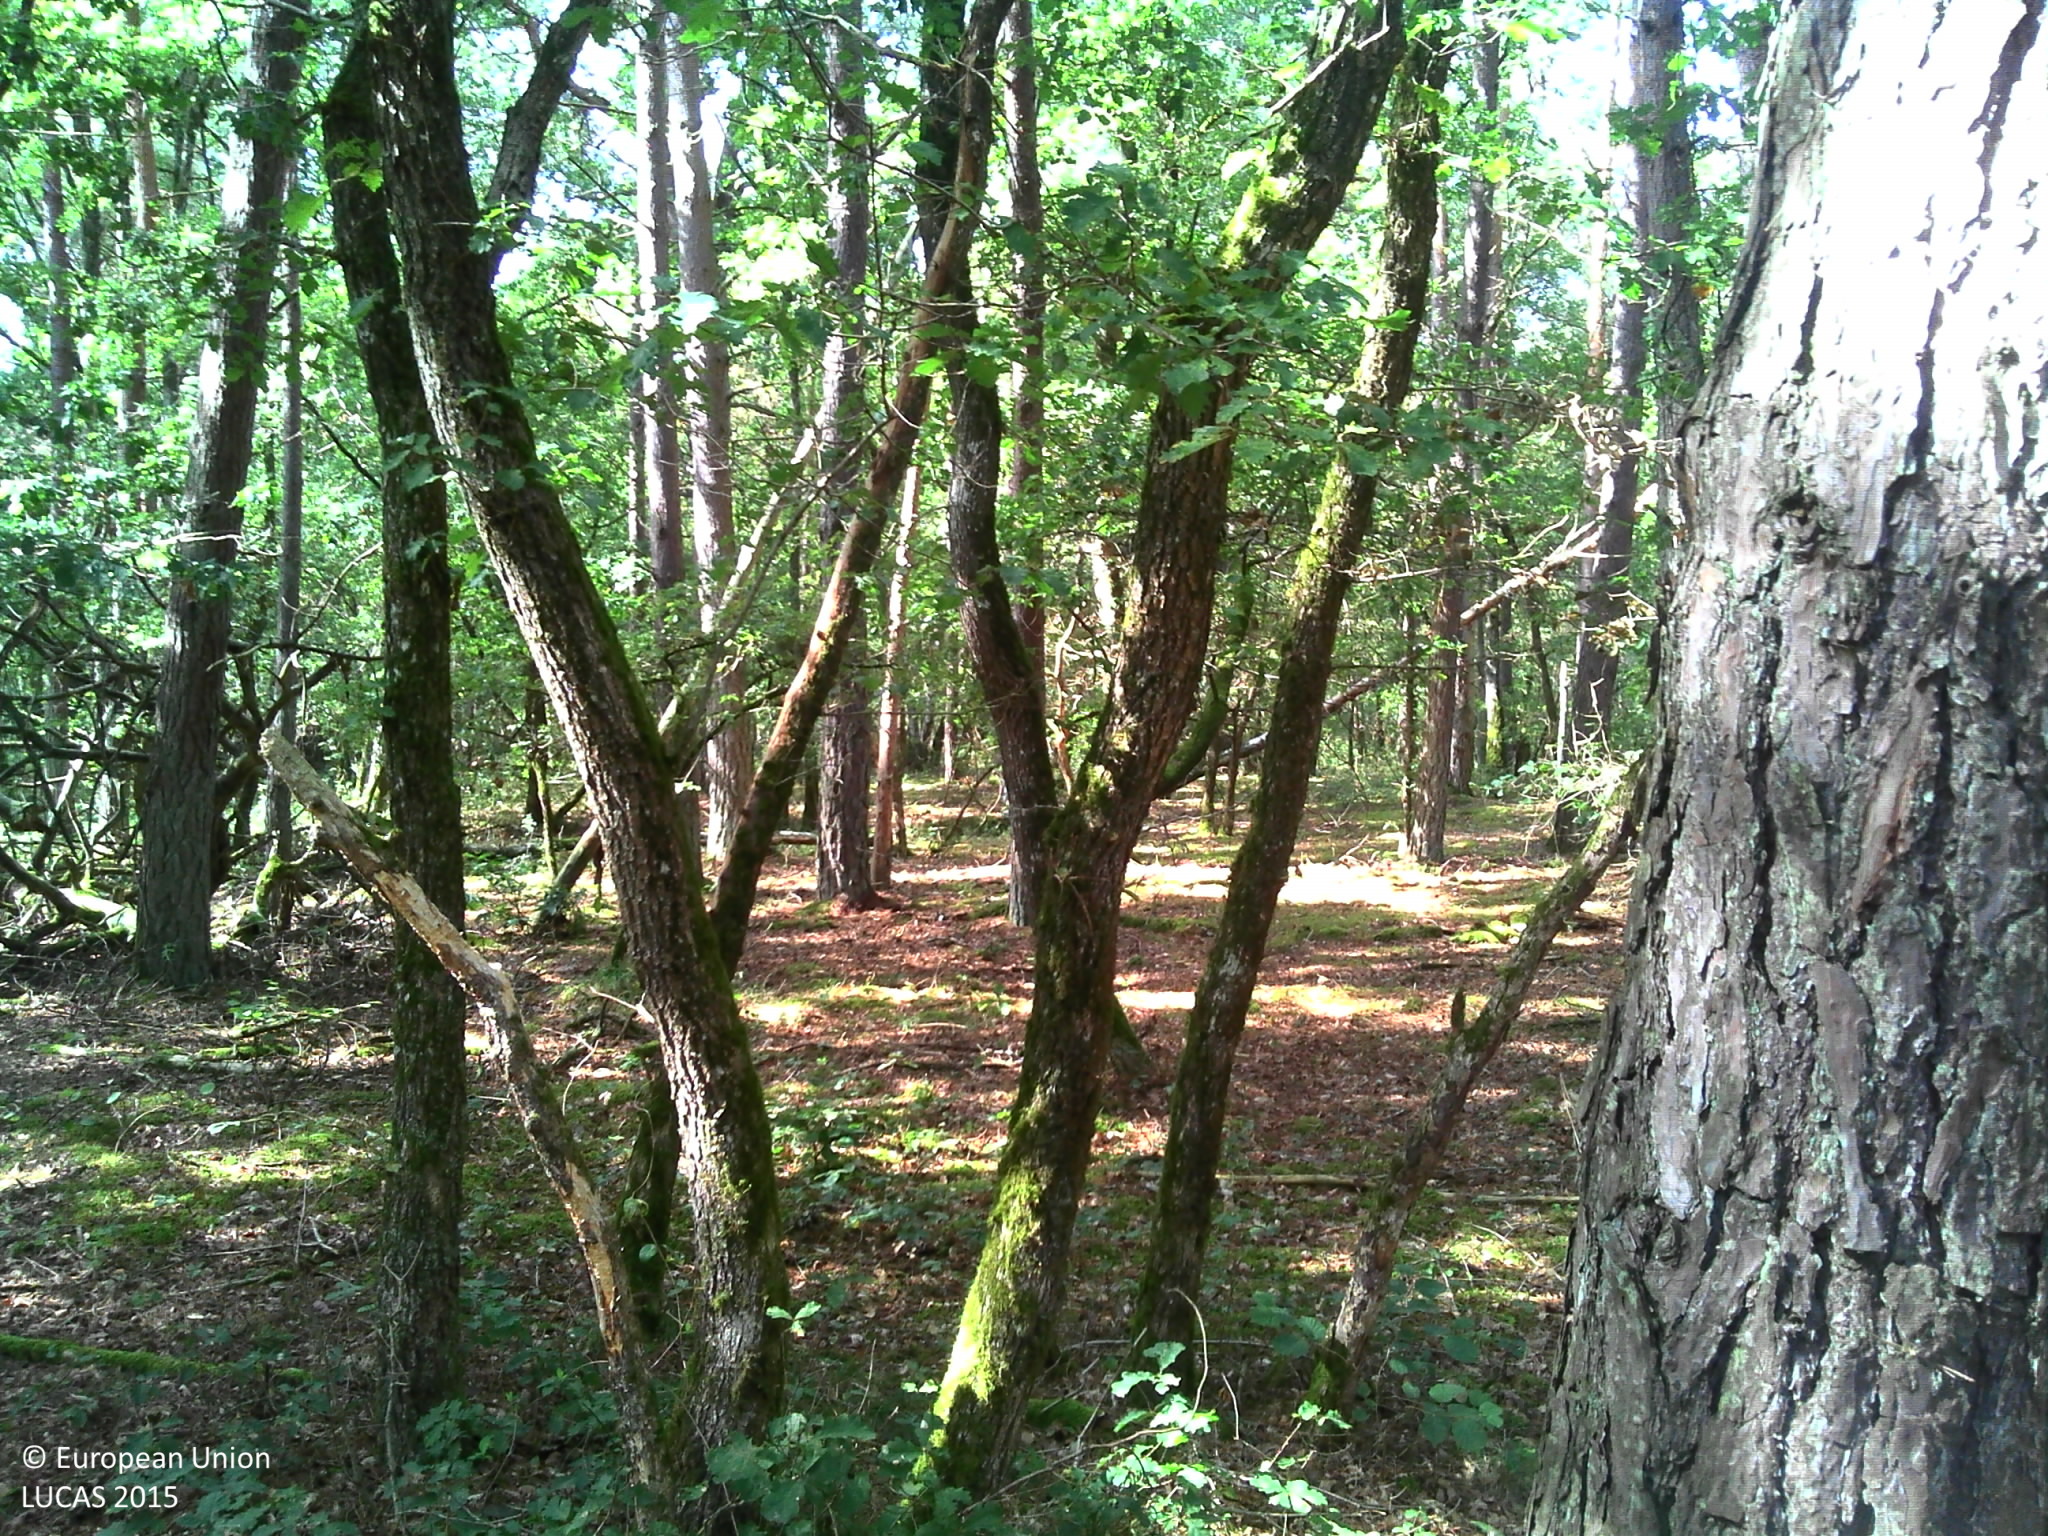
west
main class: Woodland
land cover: Pine dominated mixed woodland
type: acidophilous oak and oak-birch forest
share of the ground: > 75 %
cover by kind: coniferous forest trees 50 %, broadleaved forest trees 40 %, herbaceous plants 5 %, lichens and mosses 5 %
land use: Forestry
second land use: Amenities, museums, leisure
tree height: > 5 m
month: September
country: FR
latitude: 48.2383
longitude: 2.7608
